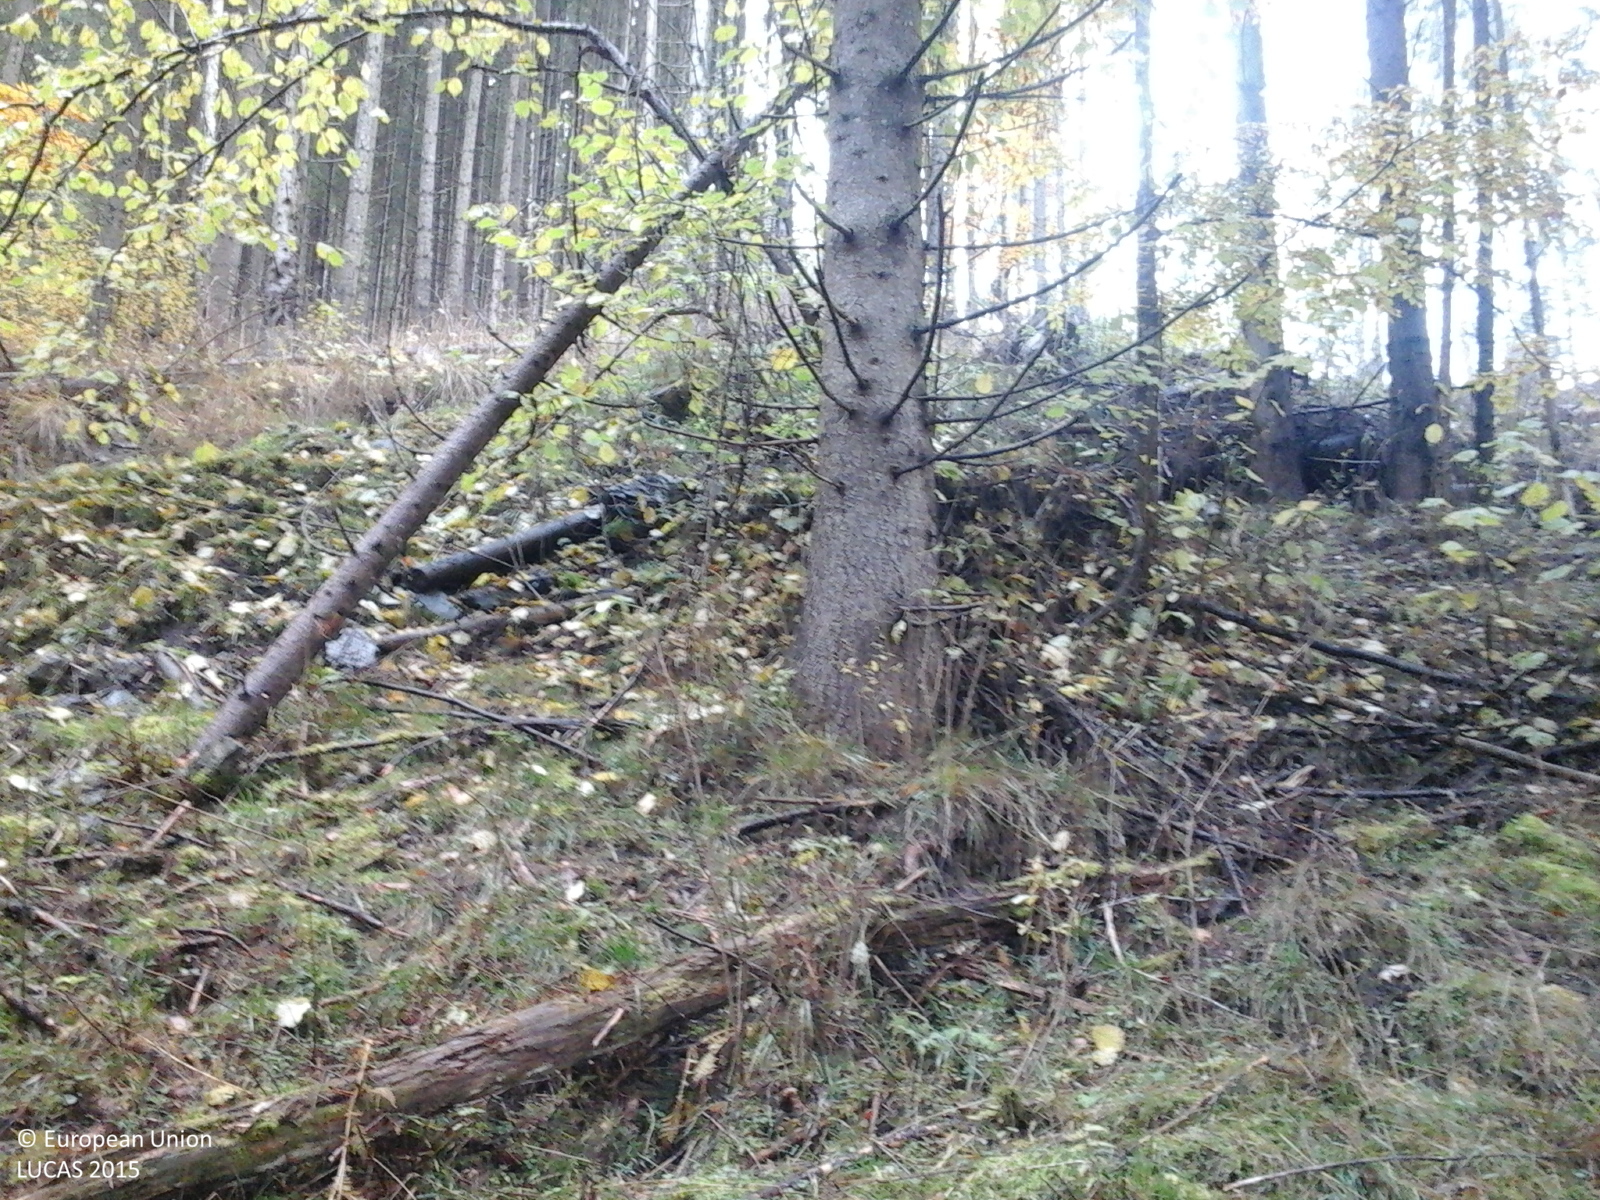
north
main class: Woodland
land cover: Spruce dominated coniferous woodland
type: alpine coniferous forest
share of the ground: > 75 %
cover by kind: coniferous forest trees 100 %
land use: Forestry
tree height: > 5 m
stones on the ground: > 50 %
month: October
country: RO
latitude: 47.0516
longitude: 25.5824
